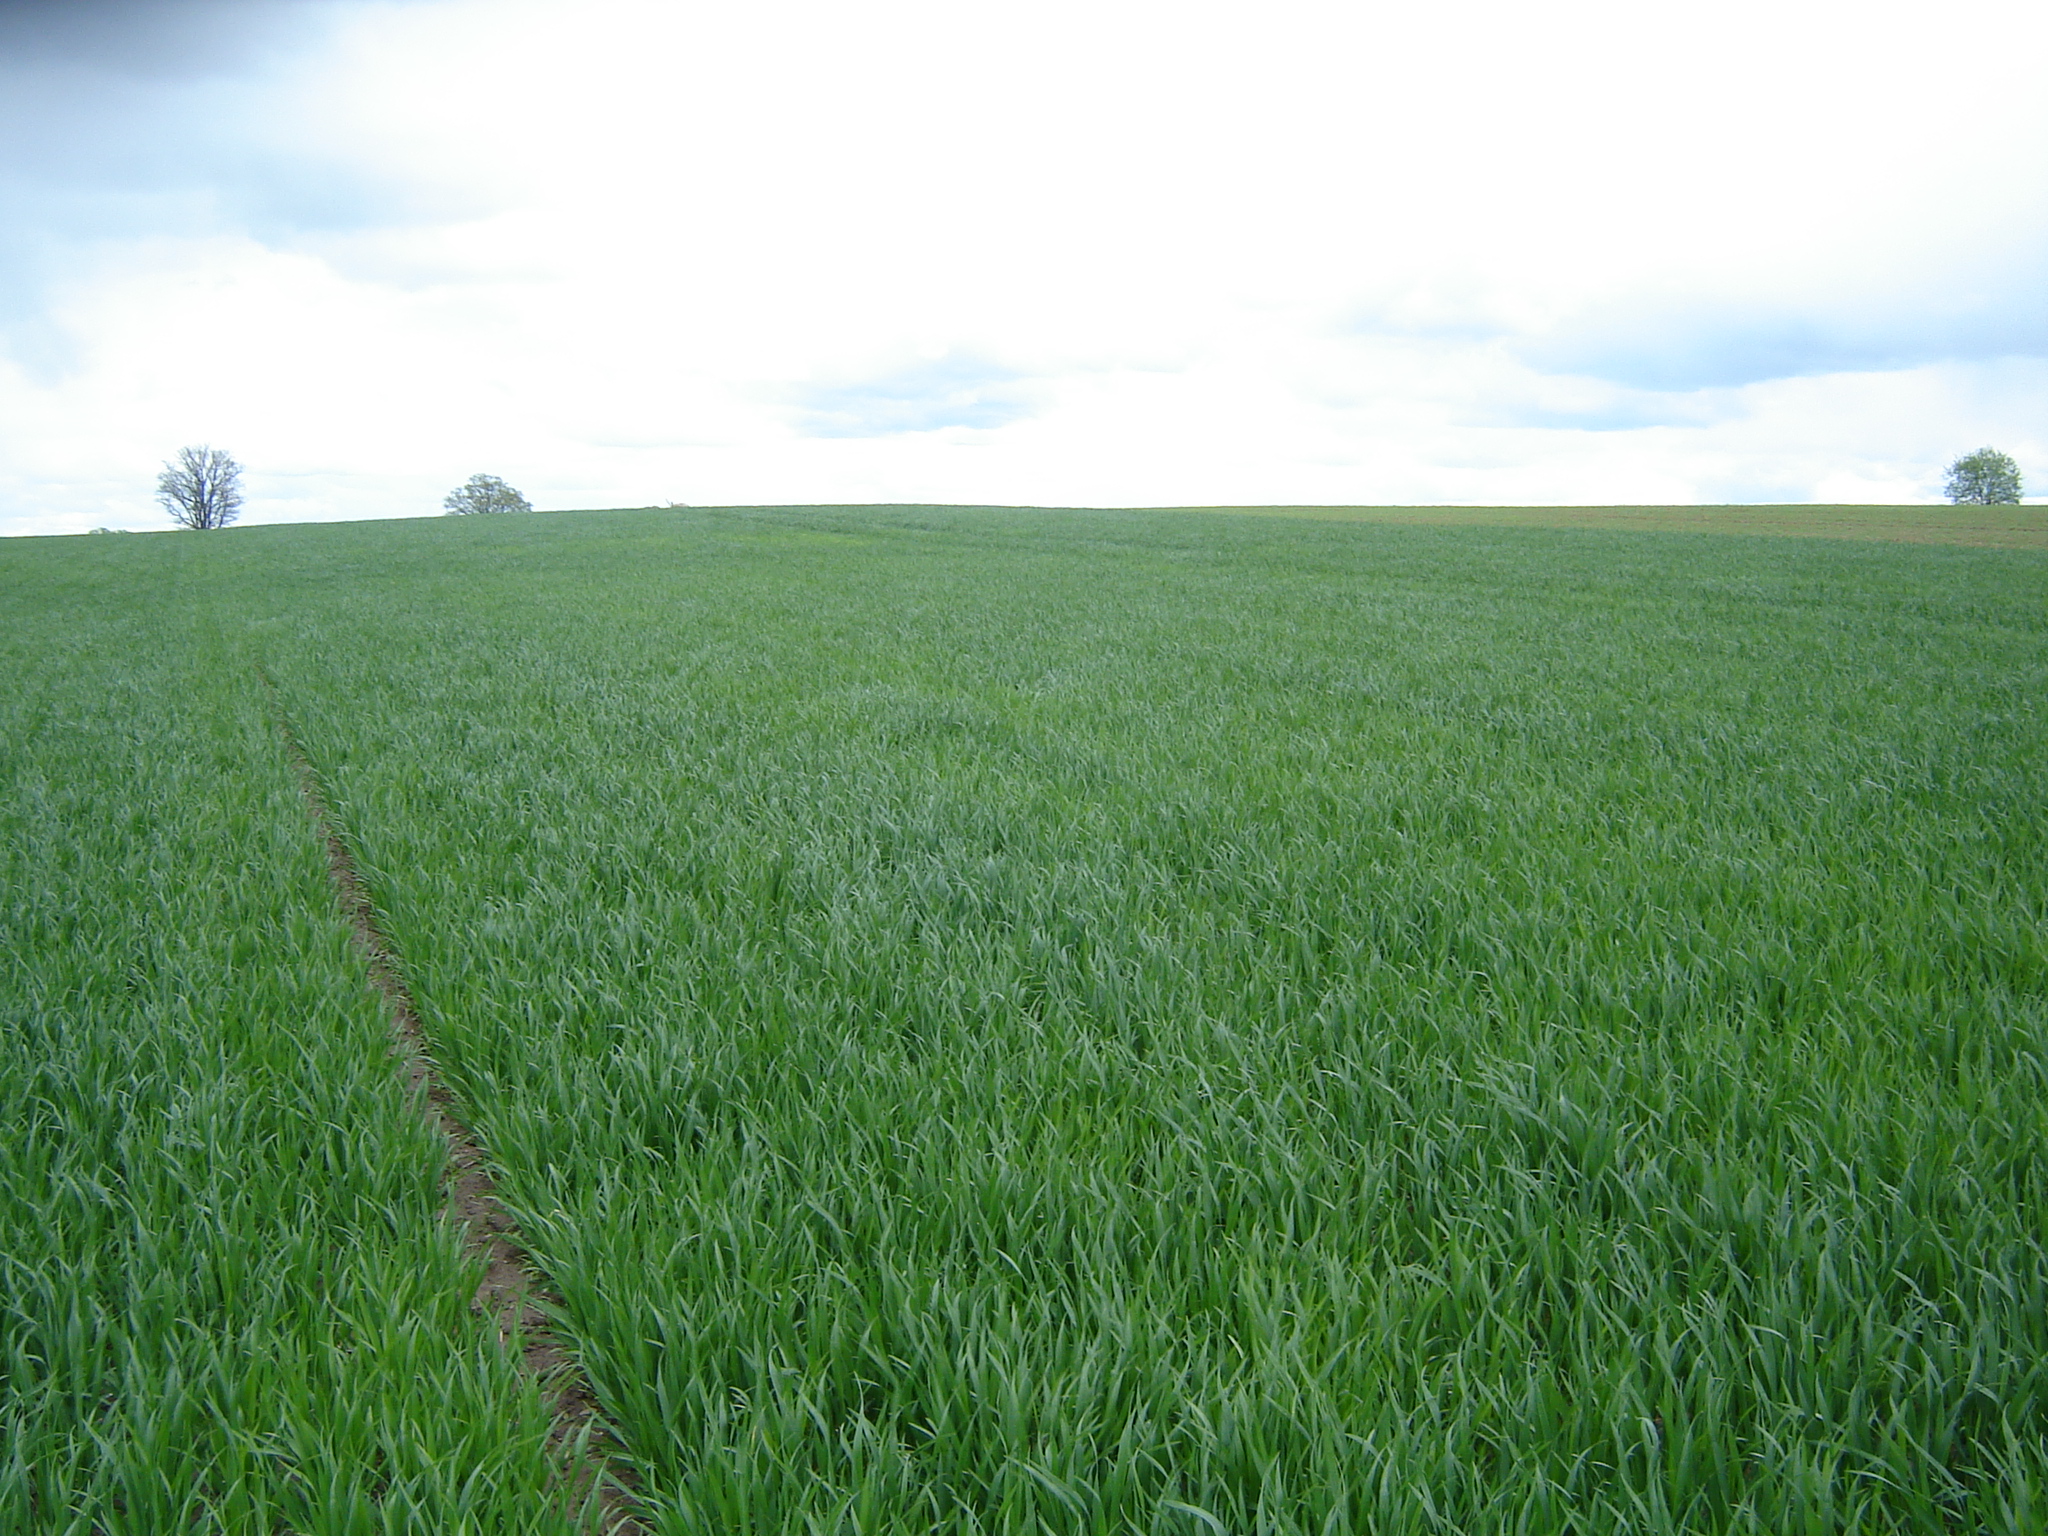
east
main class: Cropland
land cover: Barley
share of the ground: > 75 %
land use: Agriculture (excluding fallow land and kitchen gardens)
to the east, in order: Barley; Dry pulses
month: May
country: LT
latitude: 56.1320
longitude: 25.3880
